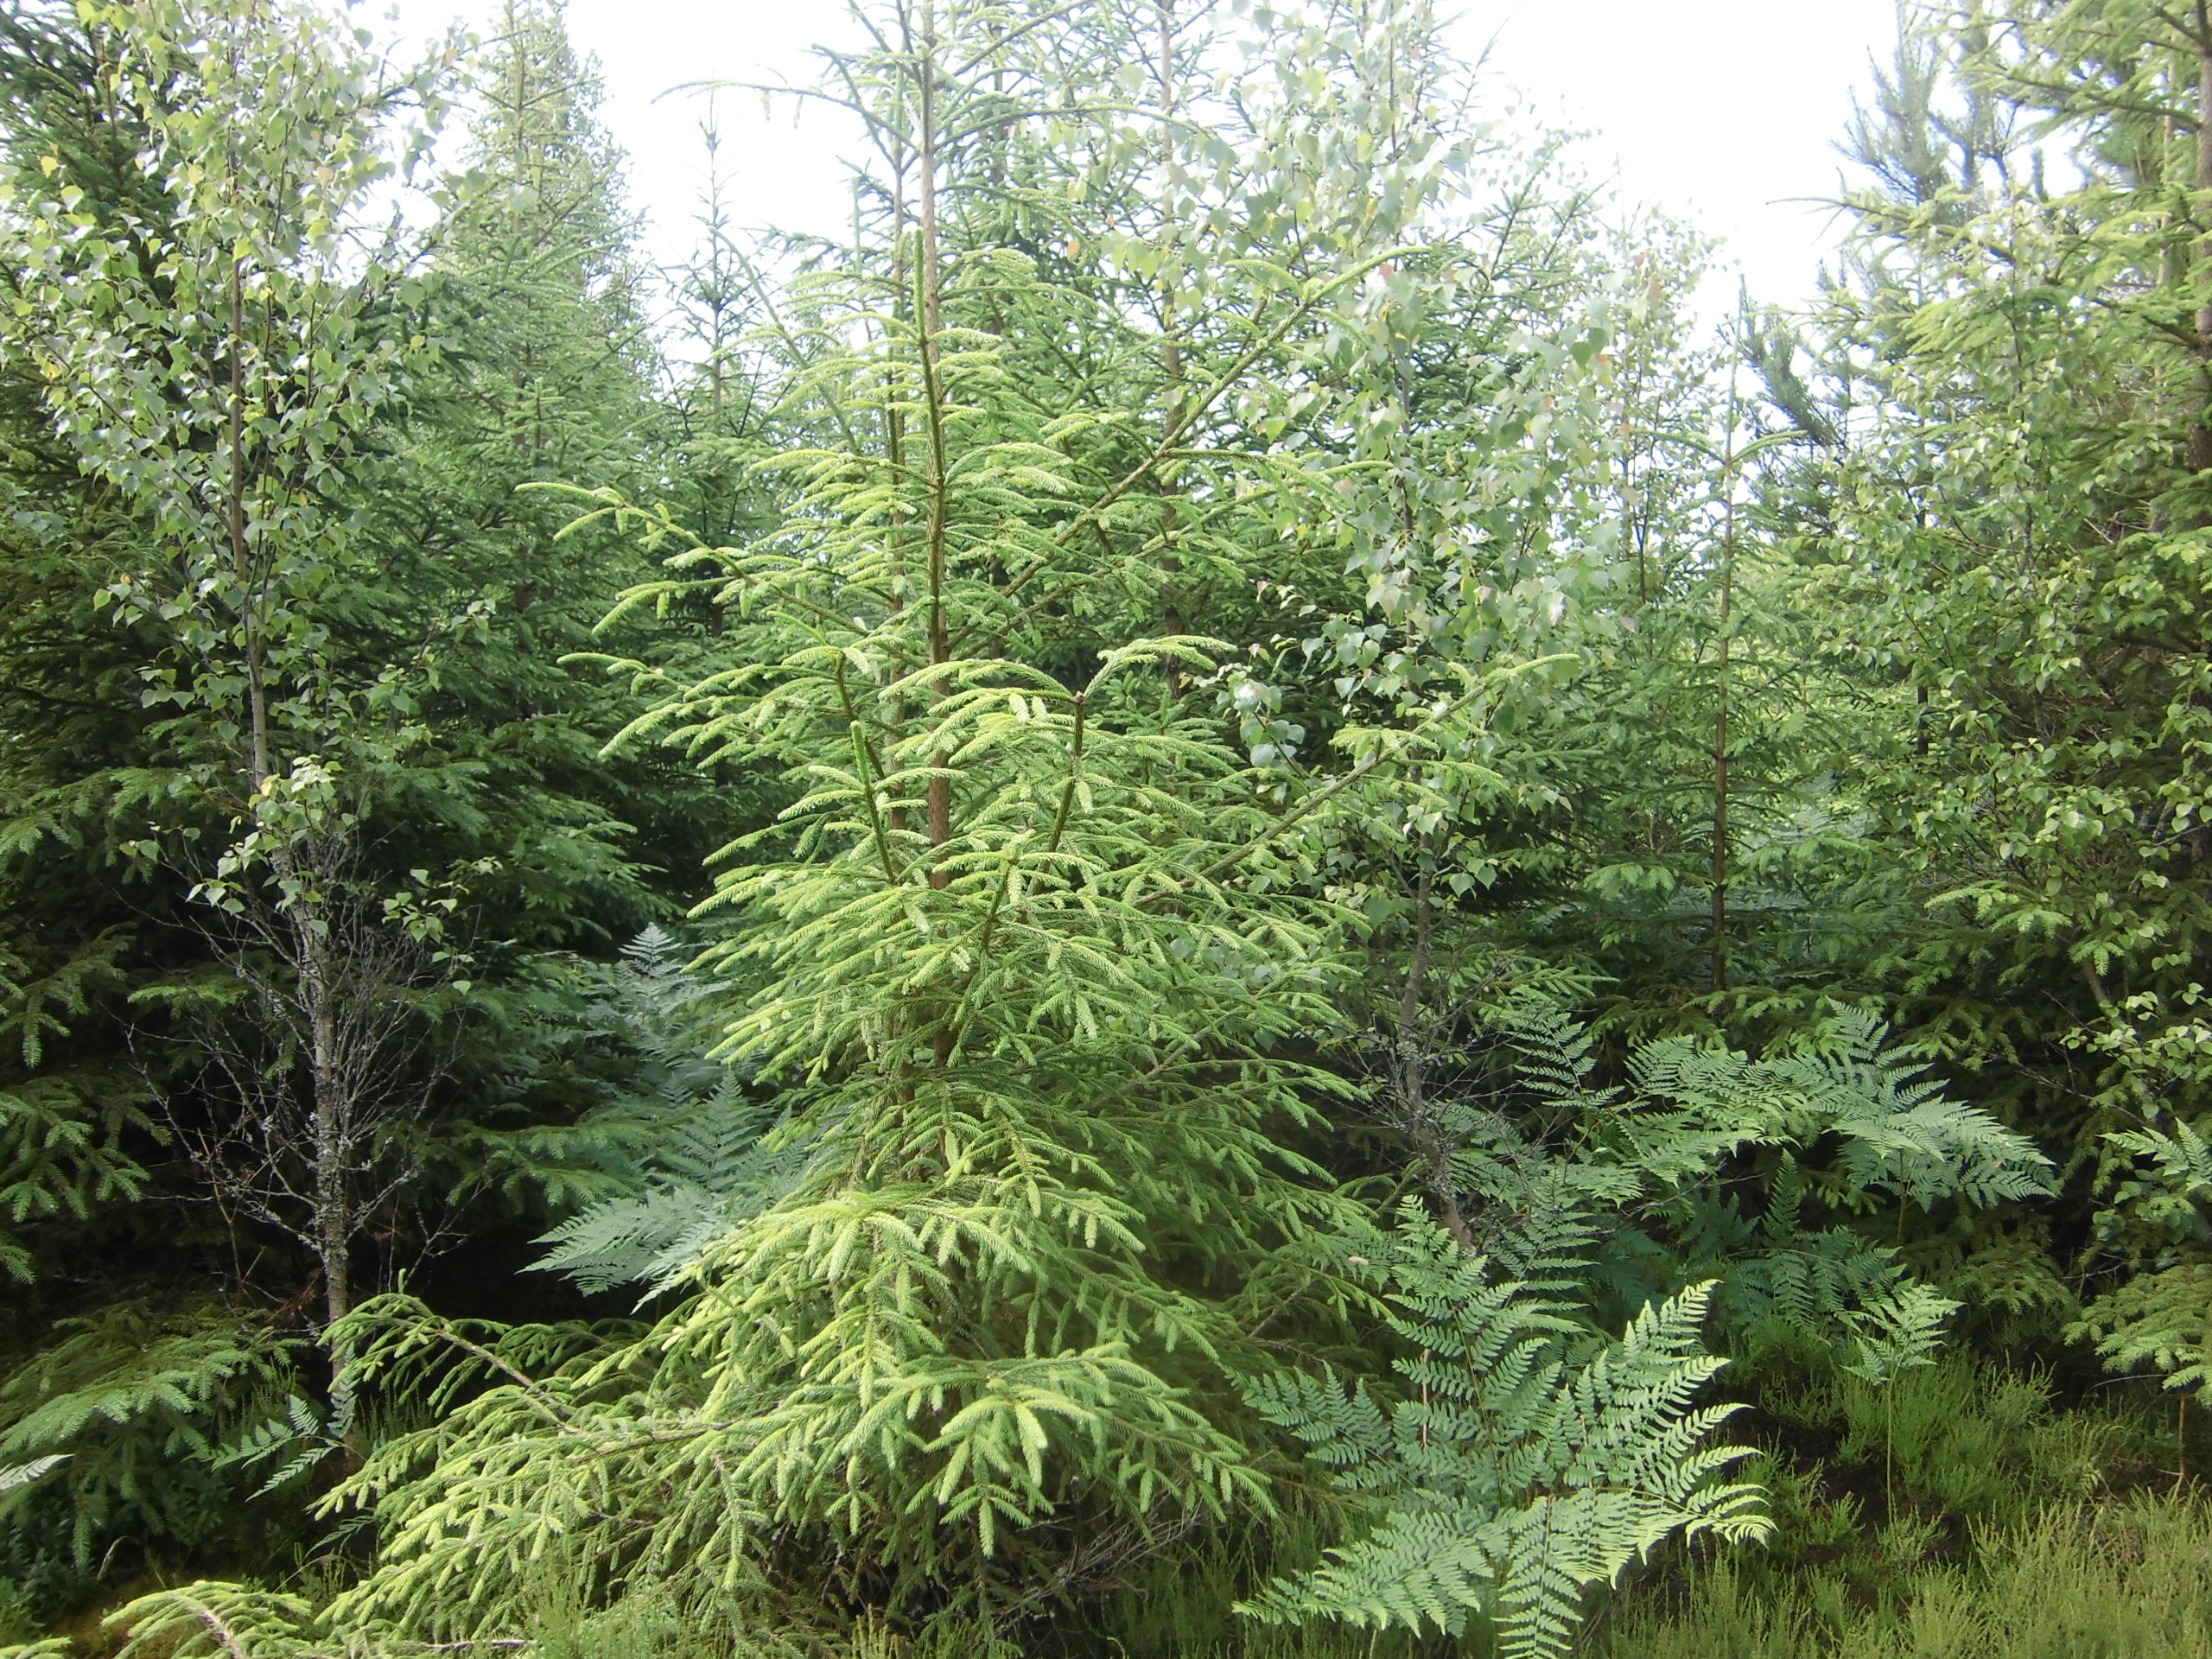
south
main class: Woodland
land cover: Spruce dominated coniferous woodland
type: boreal forest
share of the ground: 50 - 75 %
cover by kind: coniferous forest trees 50 %, shrubs 25 %, broadleaved forest trees 10 %, herbaceous plants 10 %, lichens and mosses 5 %
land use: Forestry
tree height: > 5 m
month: July
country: SE
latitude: 57.1017
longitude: 15.3956
